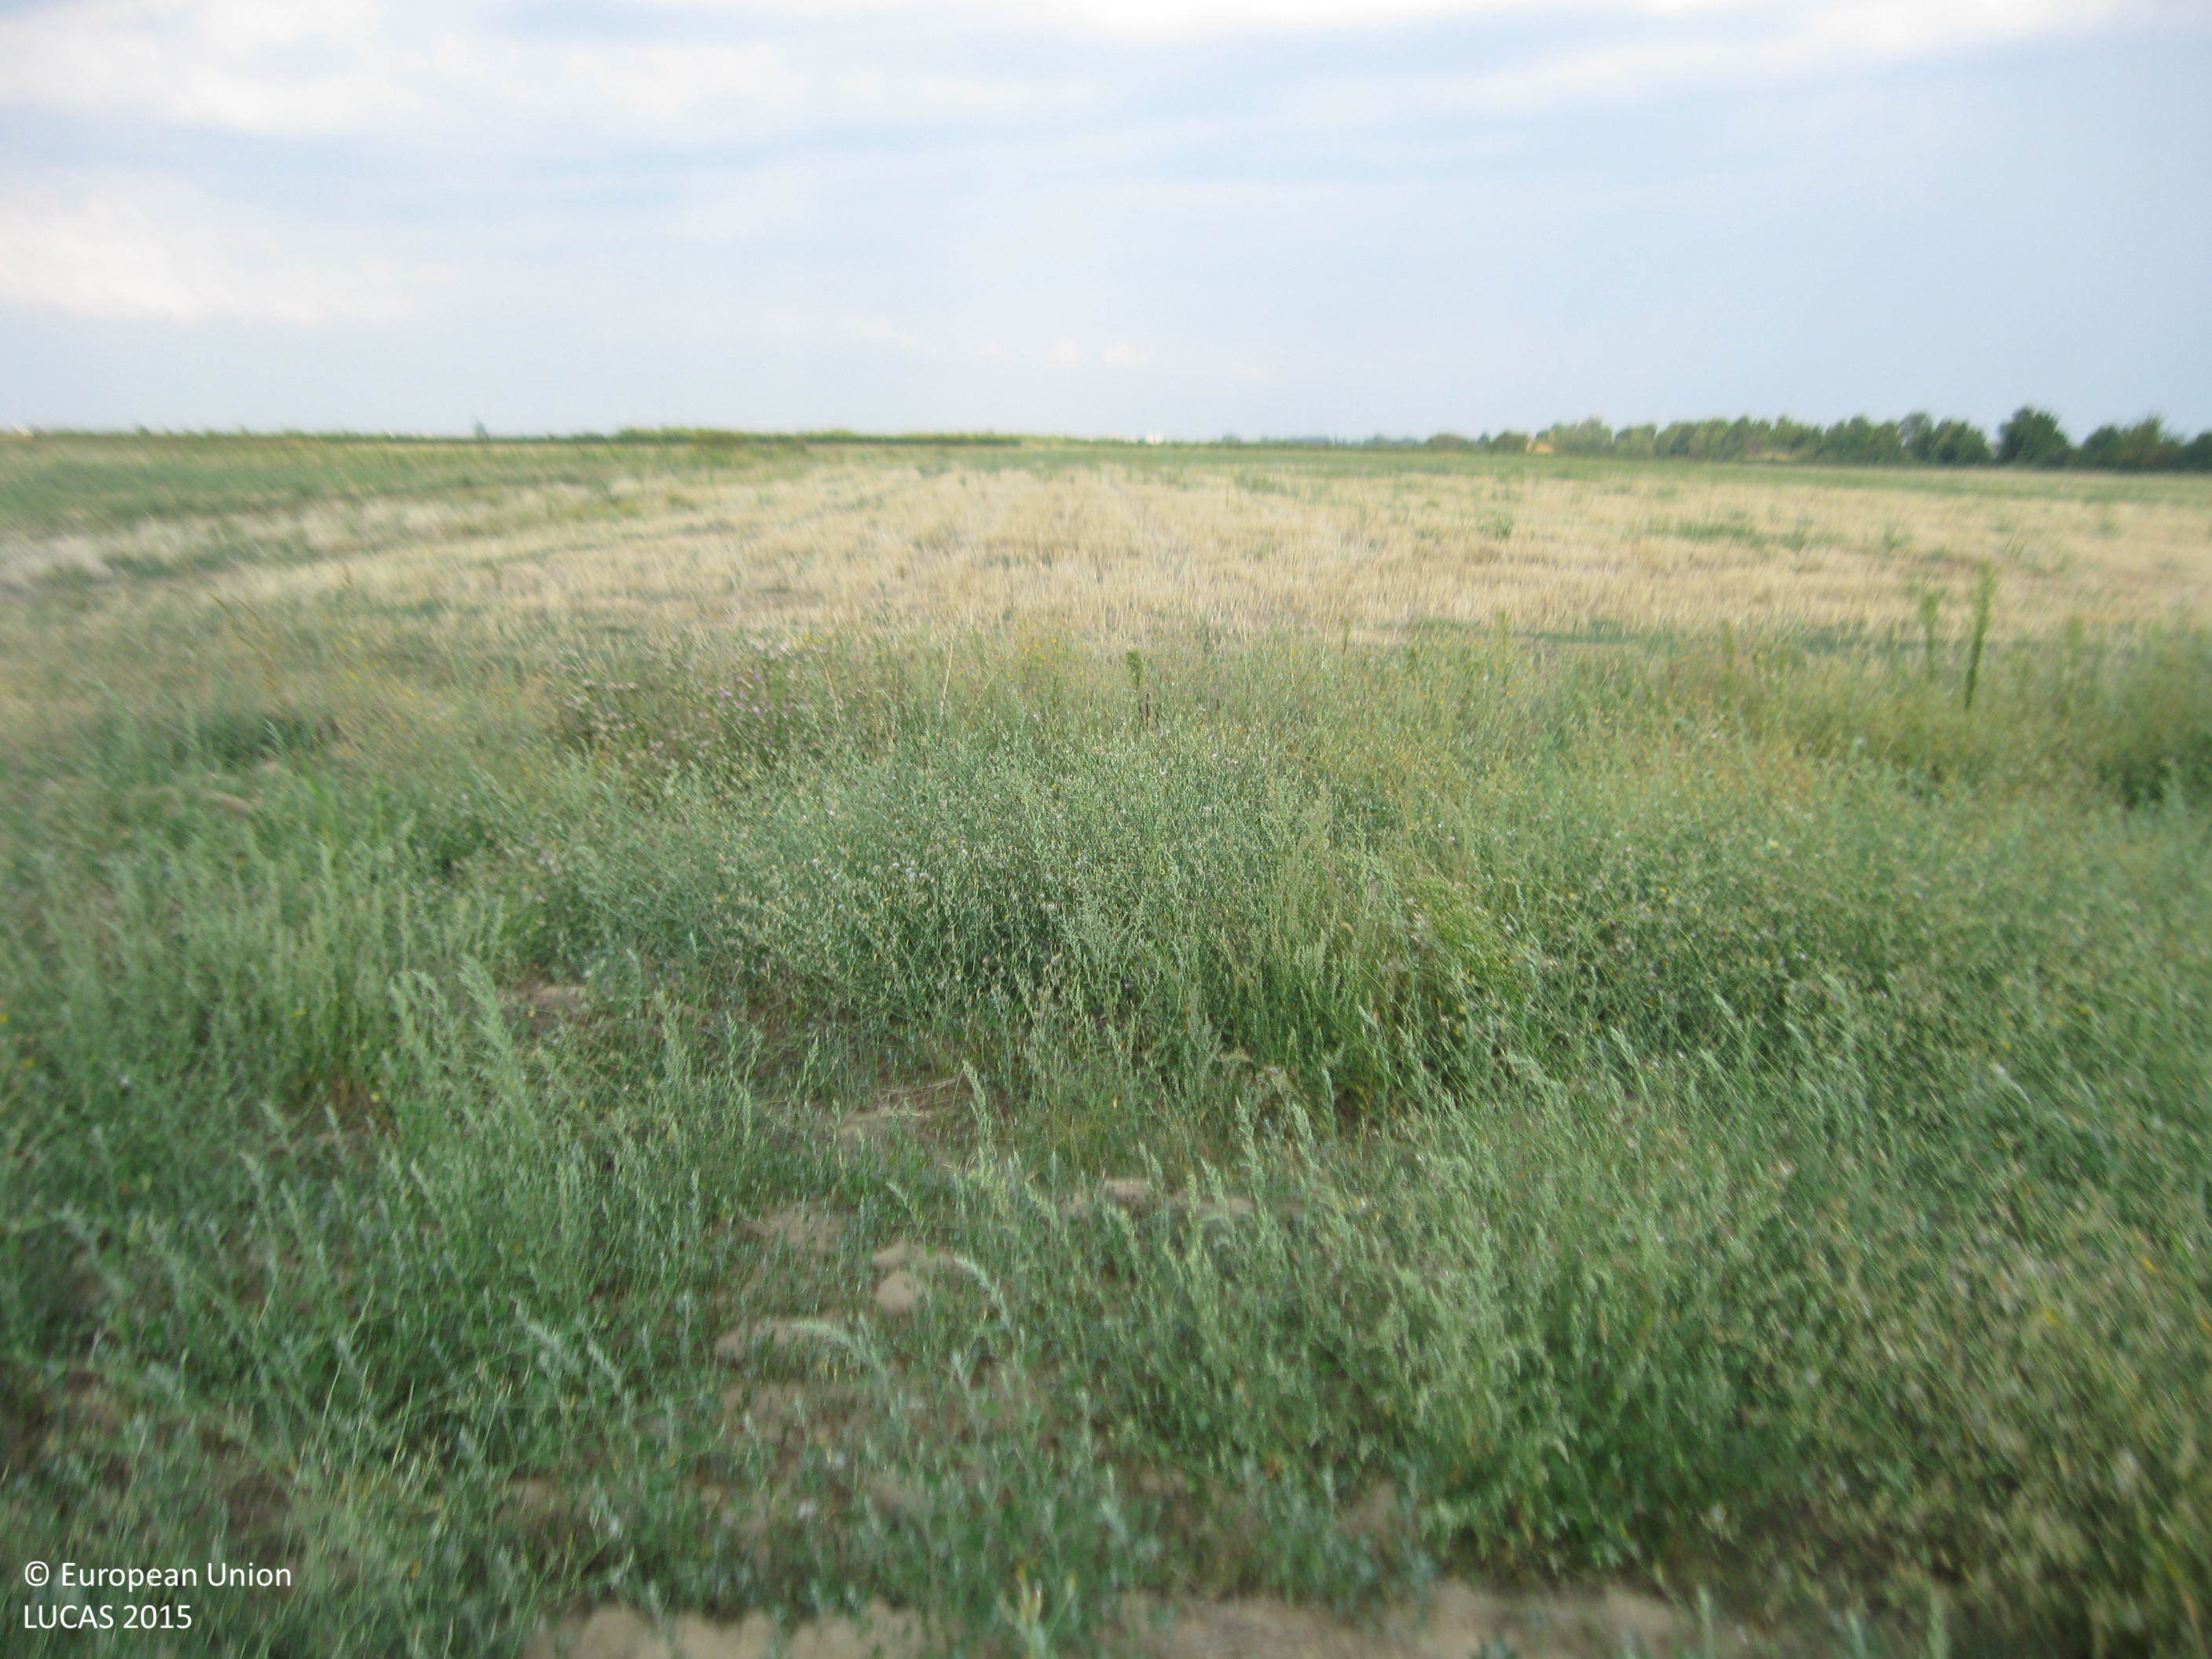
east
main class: Cropland
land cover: Oats
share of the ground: < 10 %
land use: Agriculture (excluding fallow land and kitchen gardens)
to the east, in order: Oats; Durum wheat
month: August
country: BG
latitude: 42.1599
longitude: 24.5846
